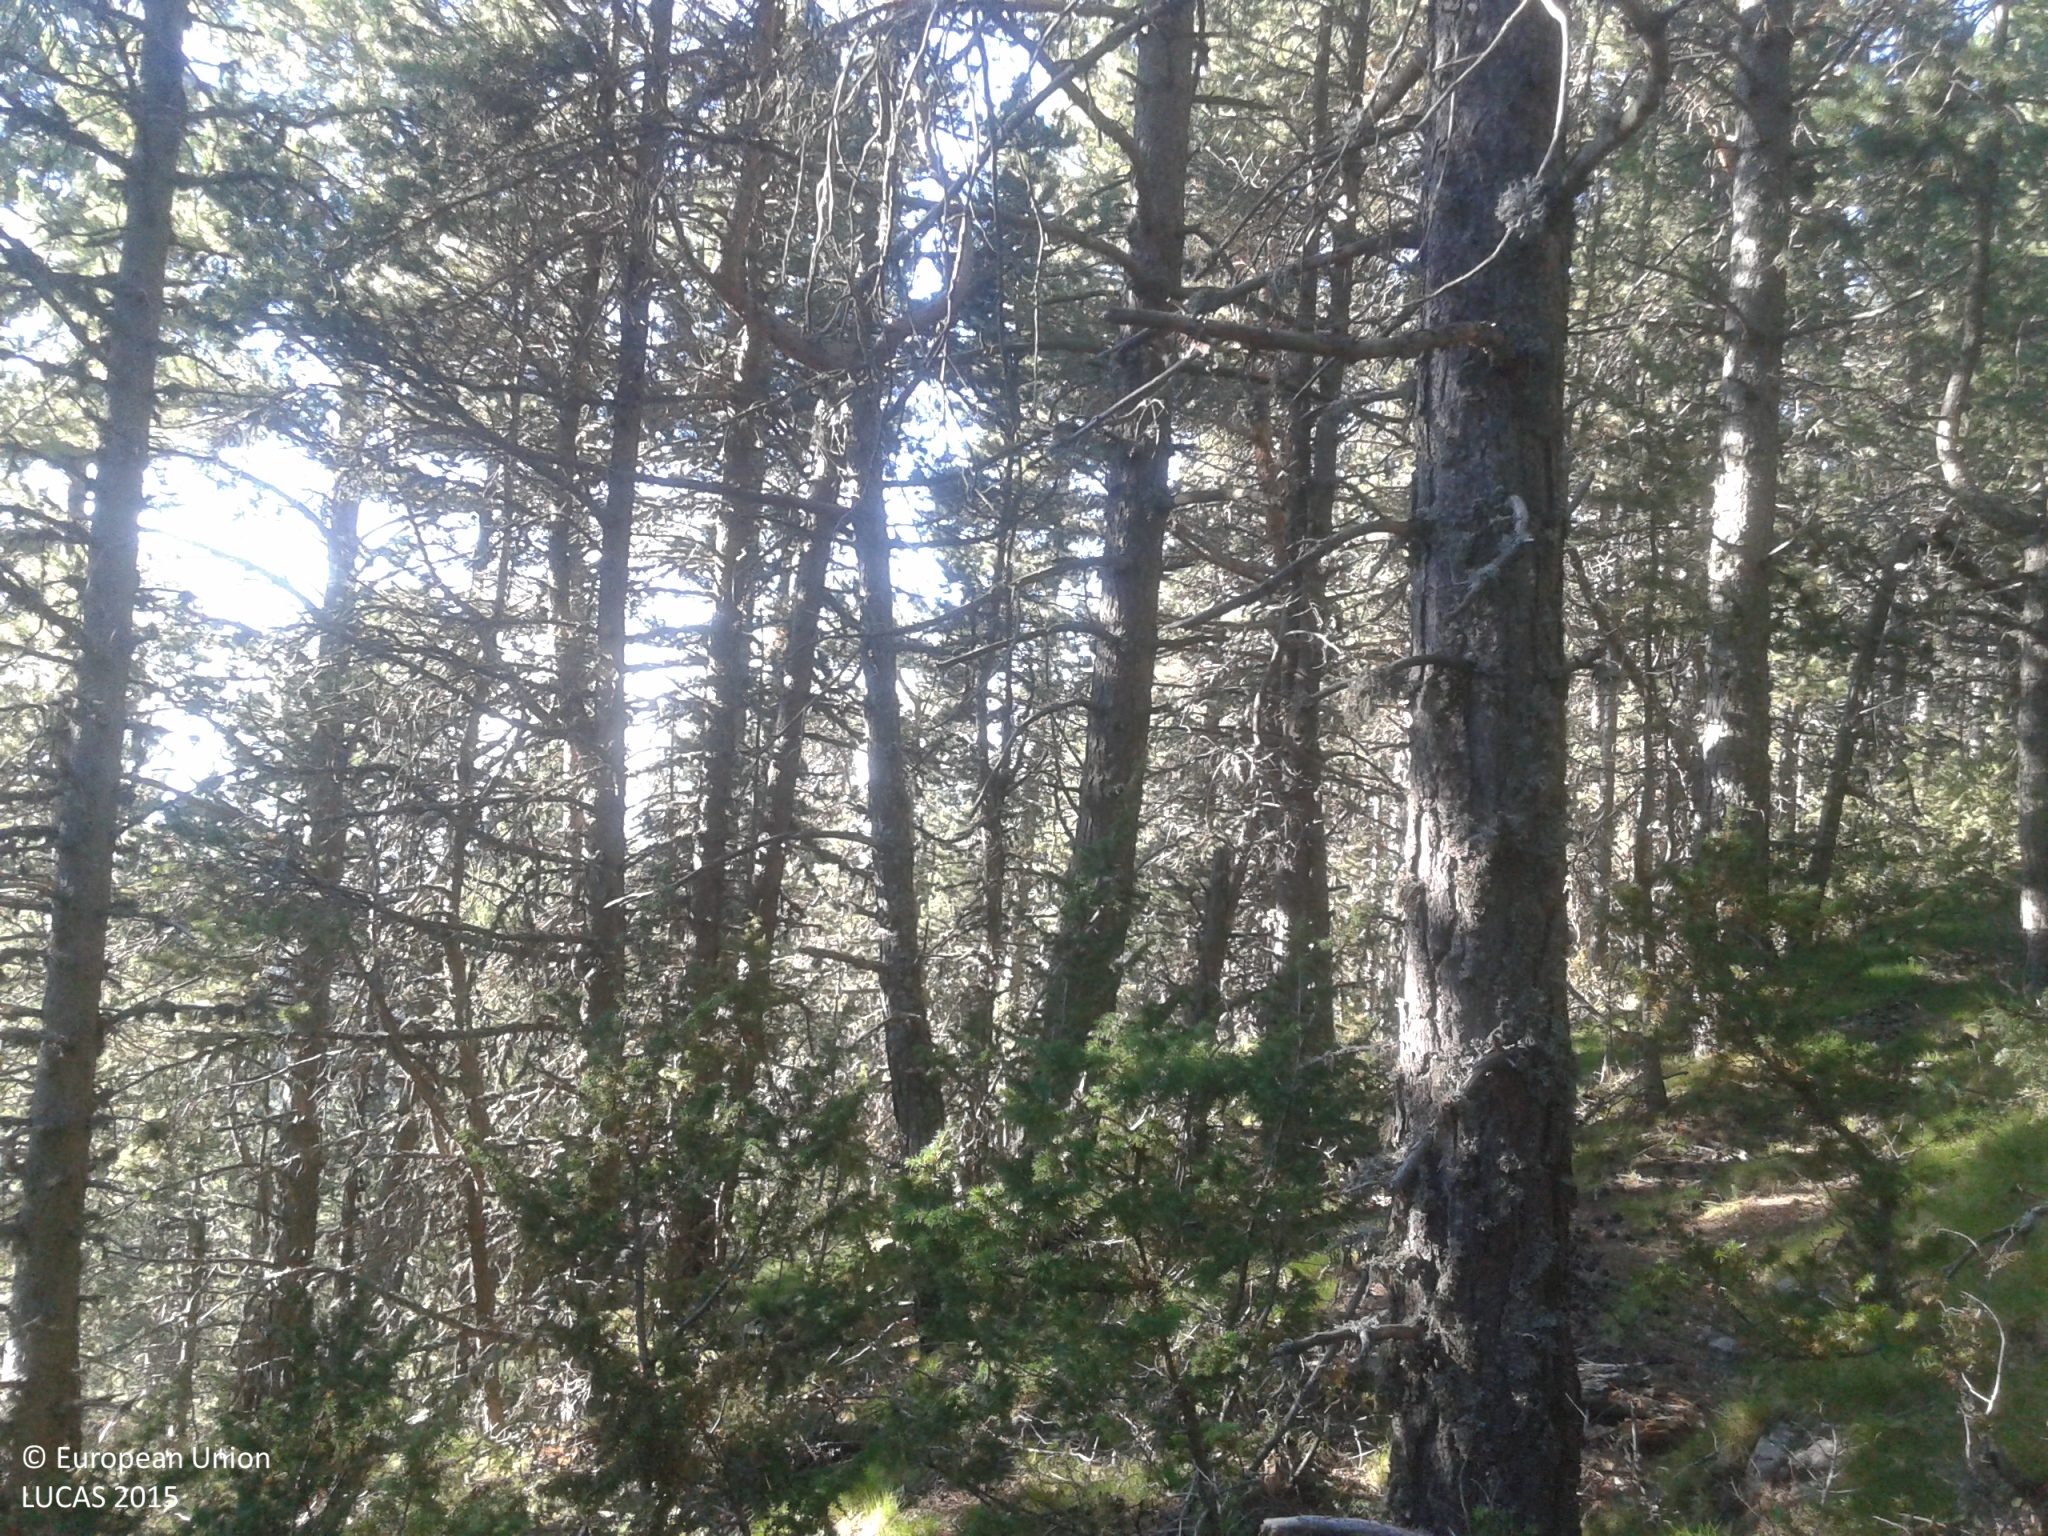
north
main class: Woodland
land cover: Pine dominated coniferous woodland
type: alpine coniferous forest
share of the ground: > 75 %
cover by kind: coniferous forest trees 80 %, herbaceous plants 15 %, shrubs 5 %
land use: Semi-natural and natural areas not in use
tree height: > 5 m
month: July
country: ES
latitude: 42.2810
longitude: 1.5345
